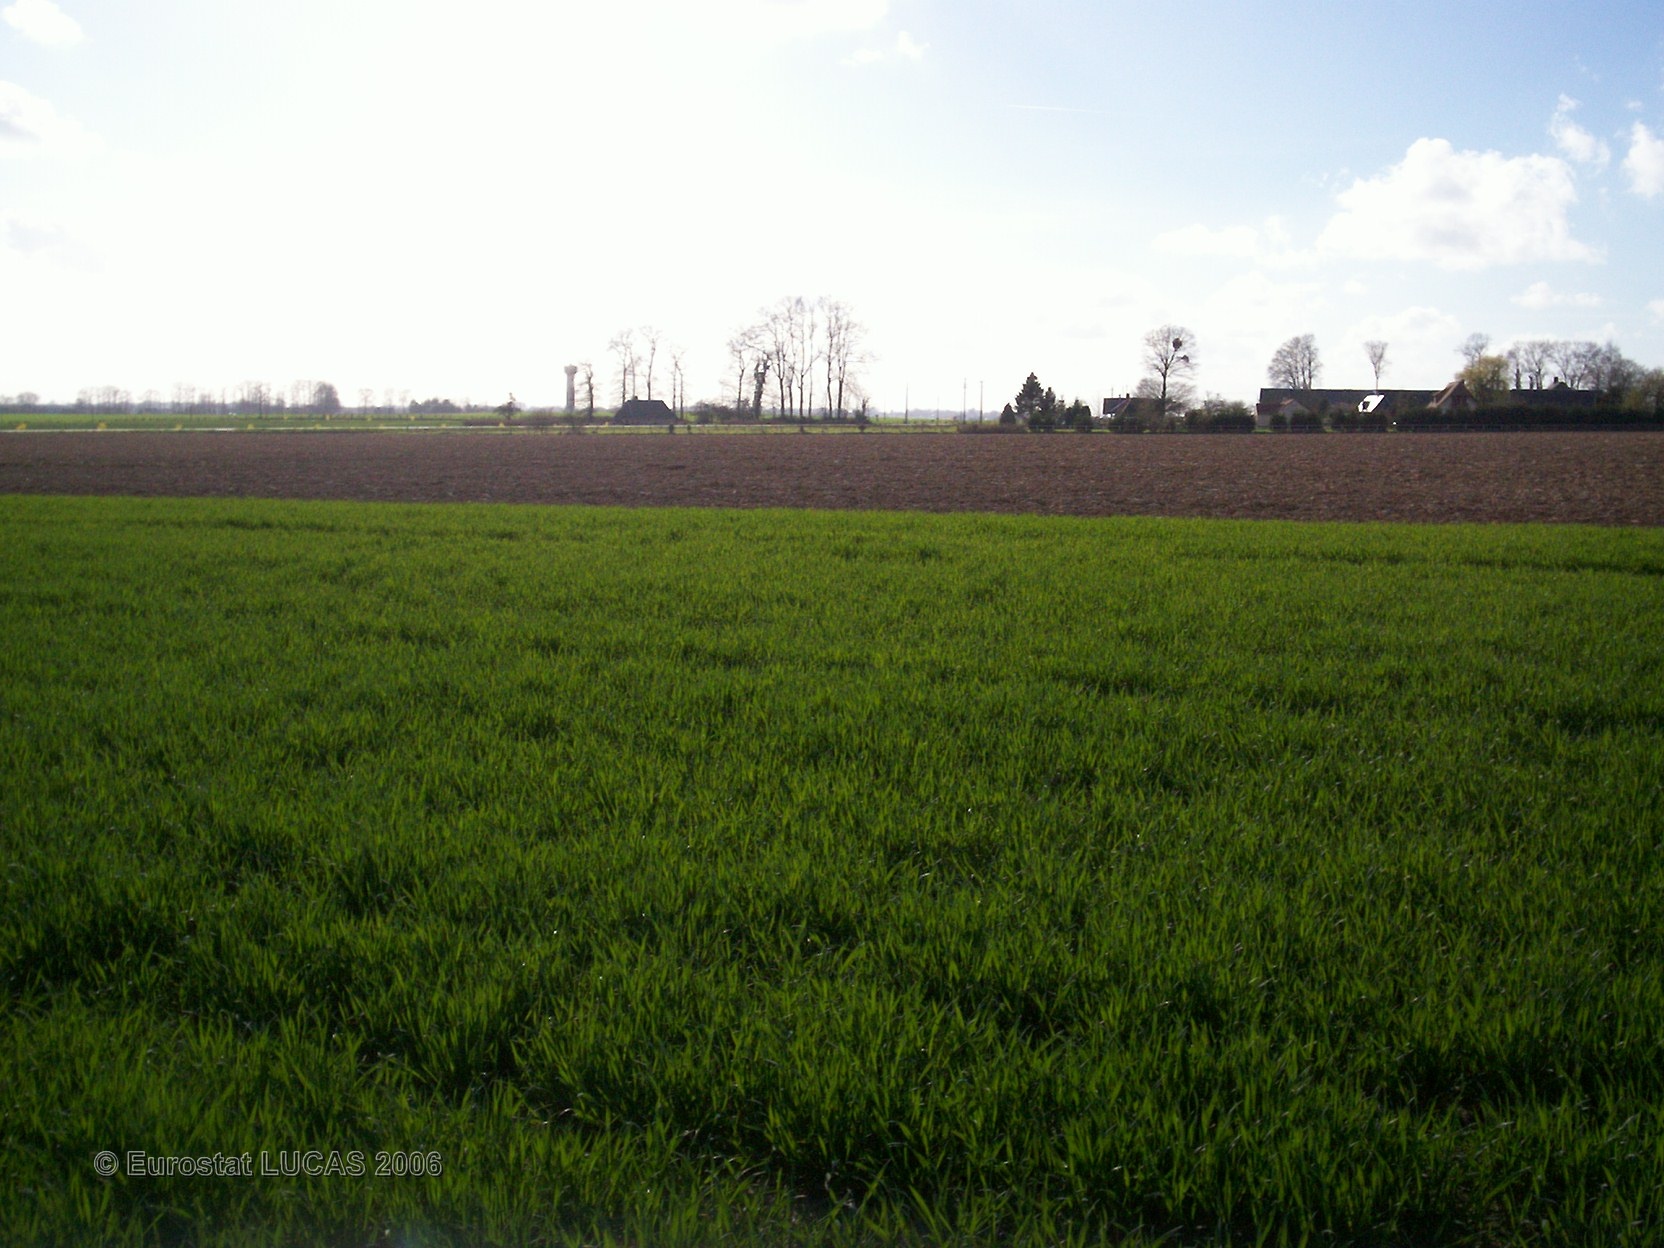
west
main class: Cropland
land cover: Common wheat
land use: Agriculture (excluding fallow land and kitchen gardens)
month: April
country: FR
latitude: 49.6058
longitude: 0.9409
